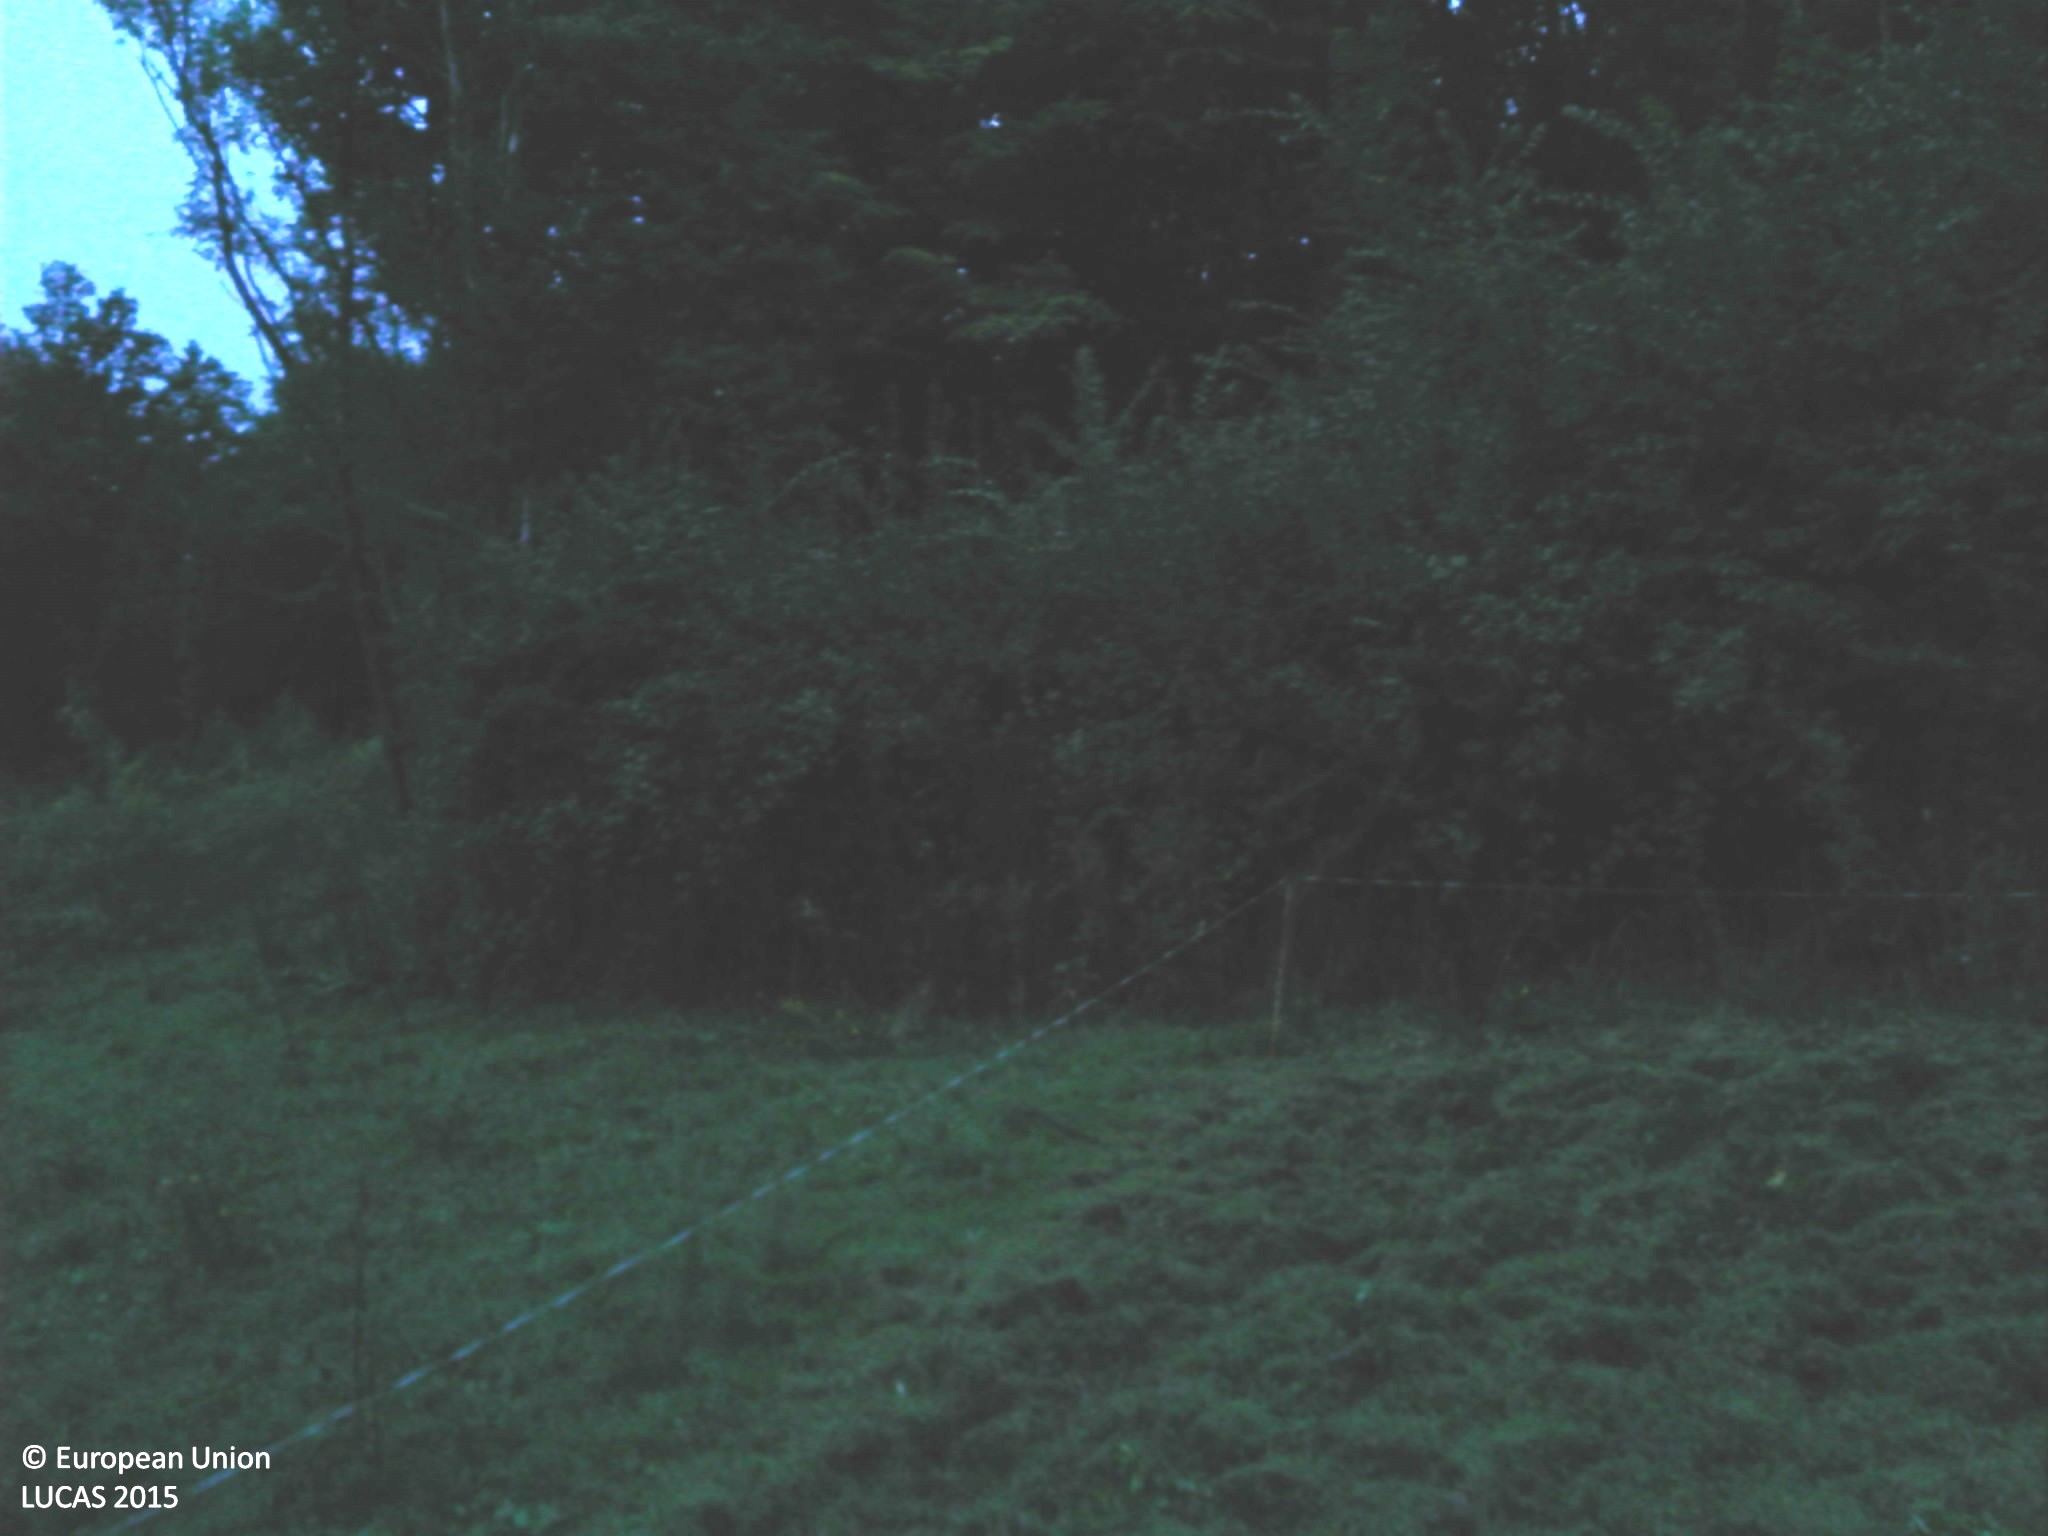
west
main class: Grassland
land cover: Grassland without tree/shrub cover
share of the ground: 50 - 75 %
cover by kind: herbaceous plants 70 %, unconsolidated bare surface 30 %
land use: Agriculture (excluding fallow land and kitchen gardens)
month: September
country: FR
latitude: 46.5457
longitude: 1.6047
